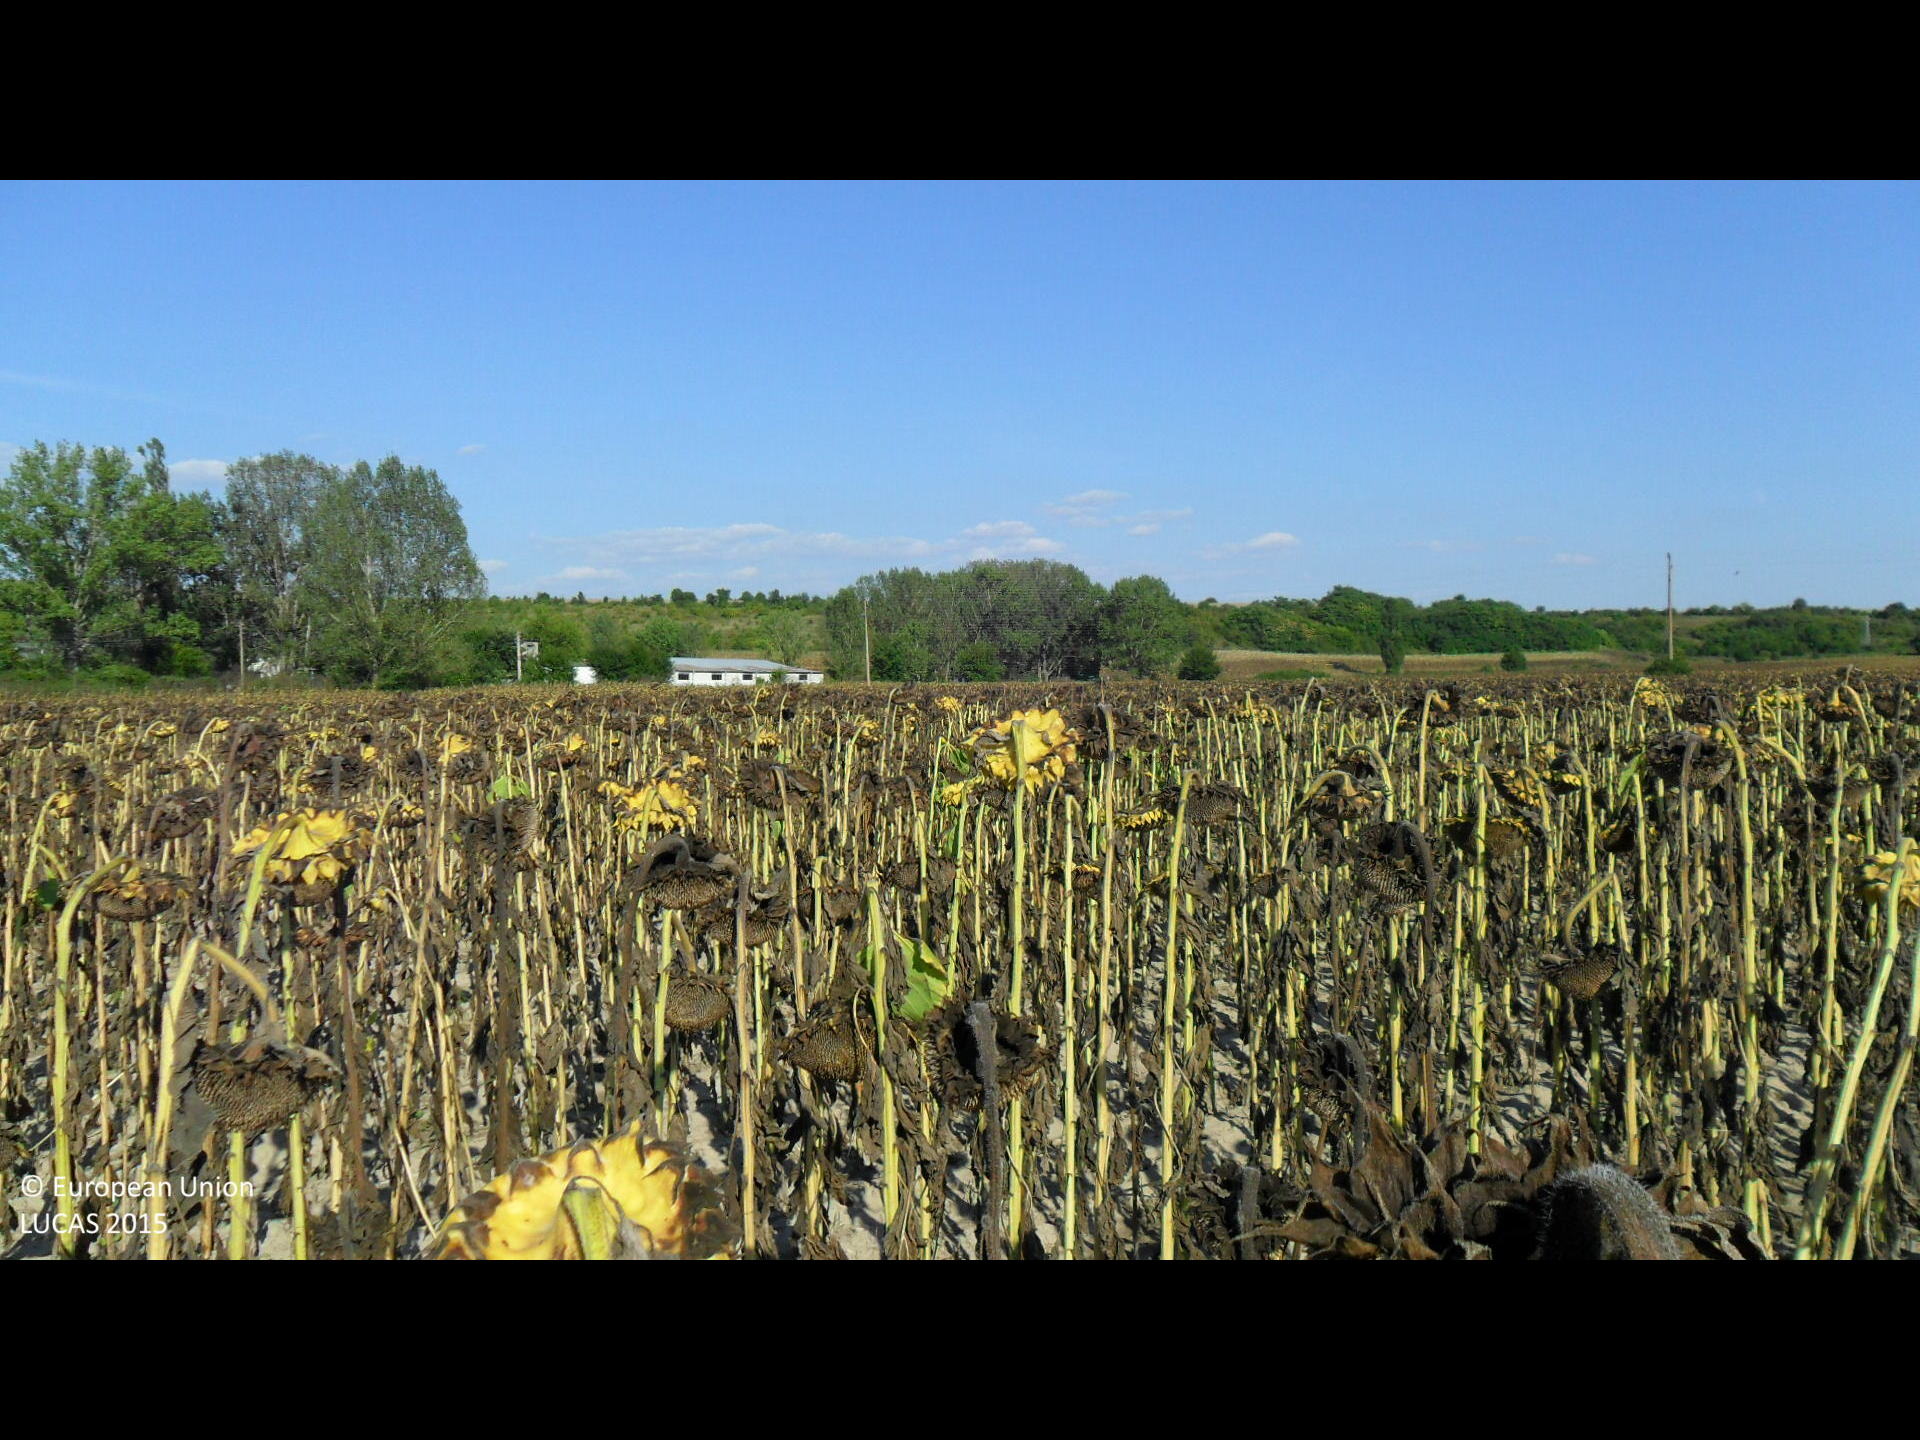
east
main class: Cropland
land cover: Sunflower
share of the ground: > 75 %
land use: Agriculture (excluding fallow land and kitchen gardens)
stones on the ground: < 10 %
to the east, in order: Sunflower; Electric lines; Sunflower
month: August
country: BG
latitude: 43.4728
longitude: 26.3061
